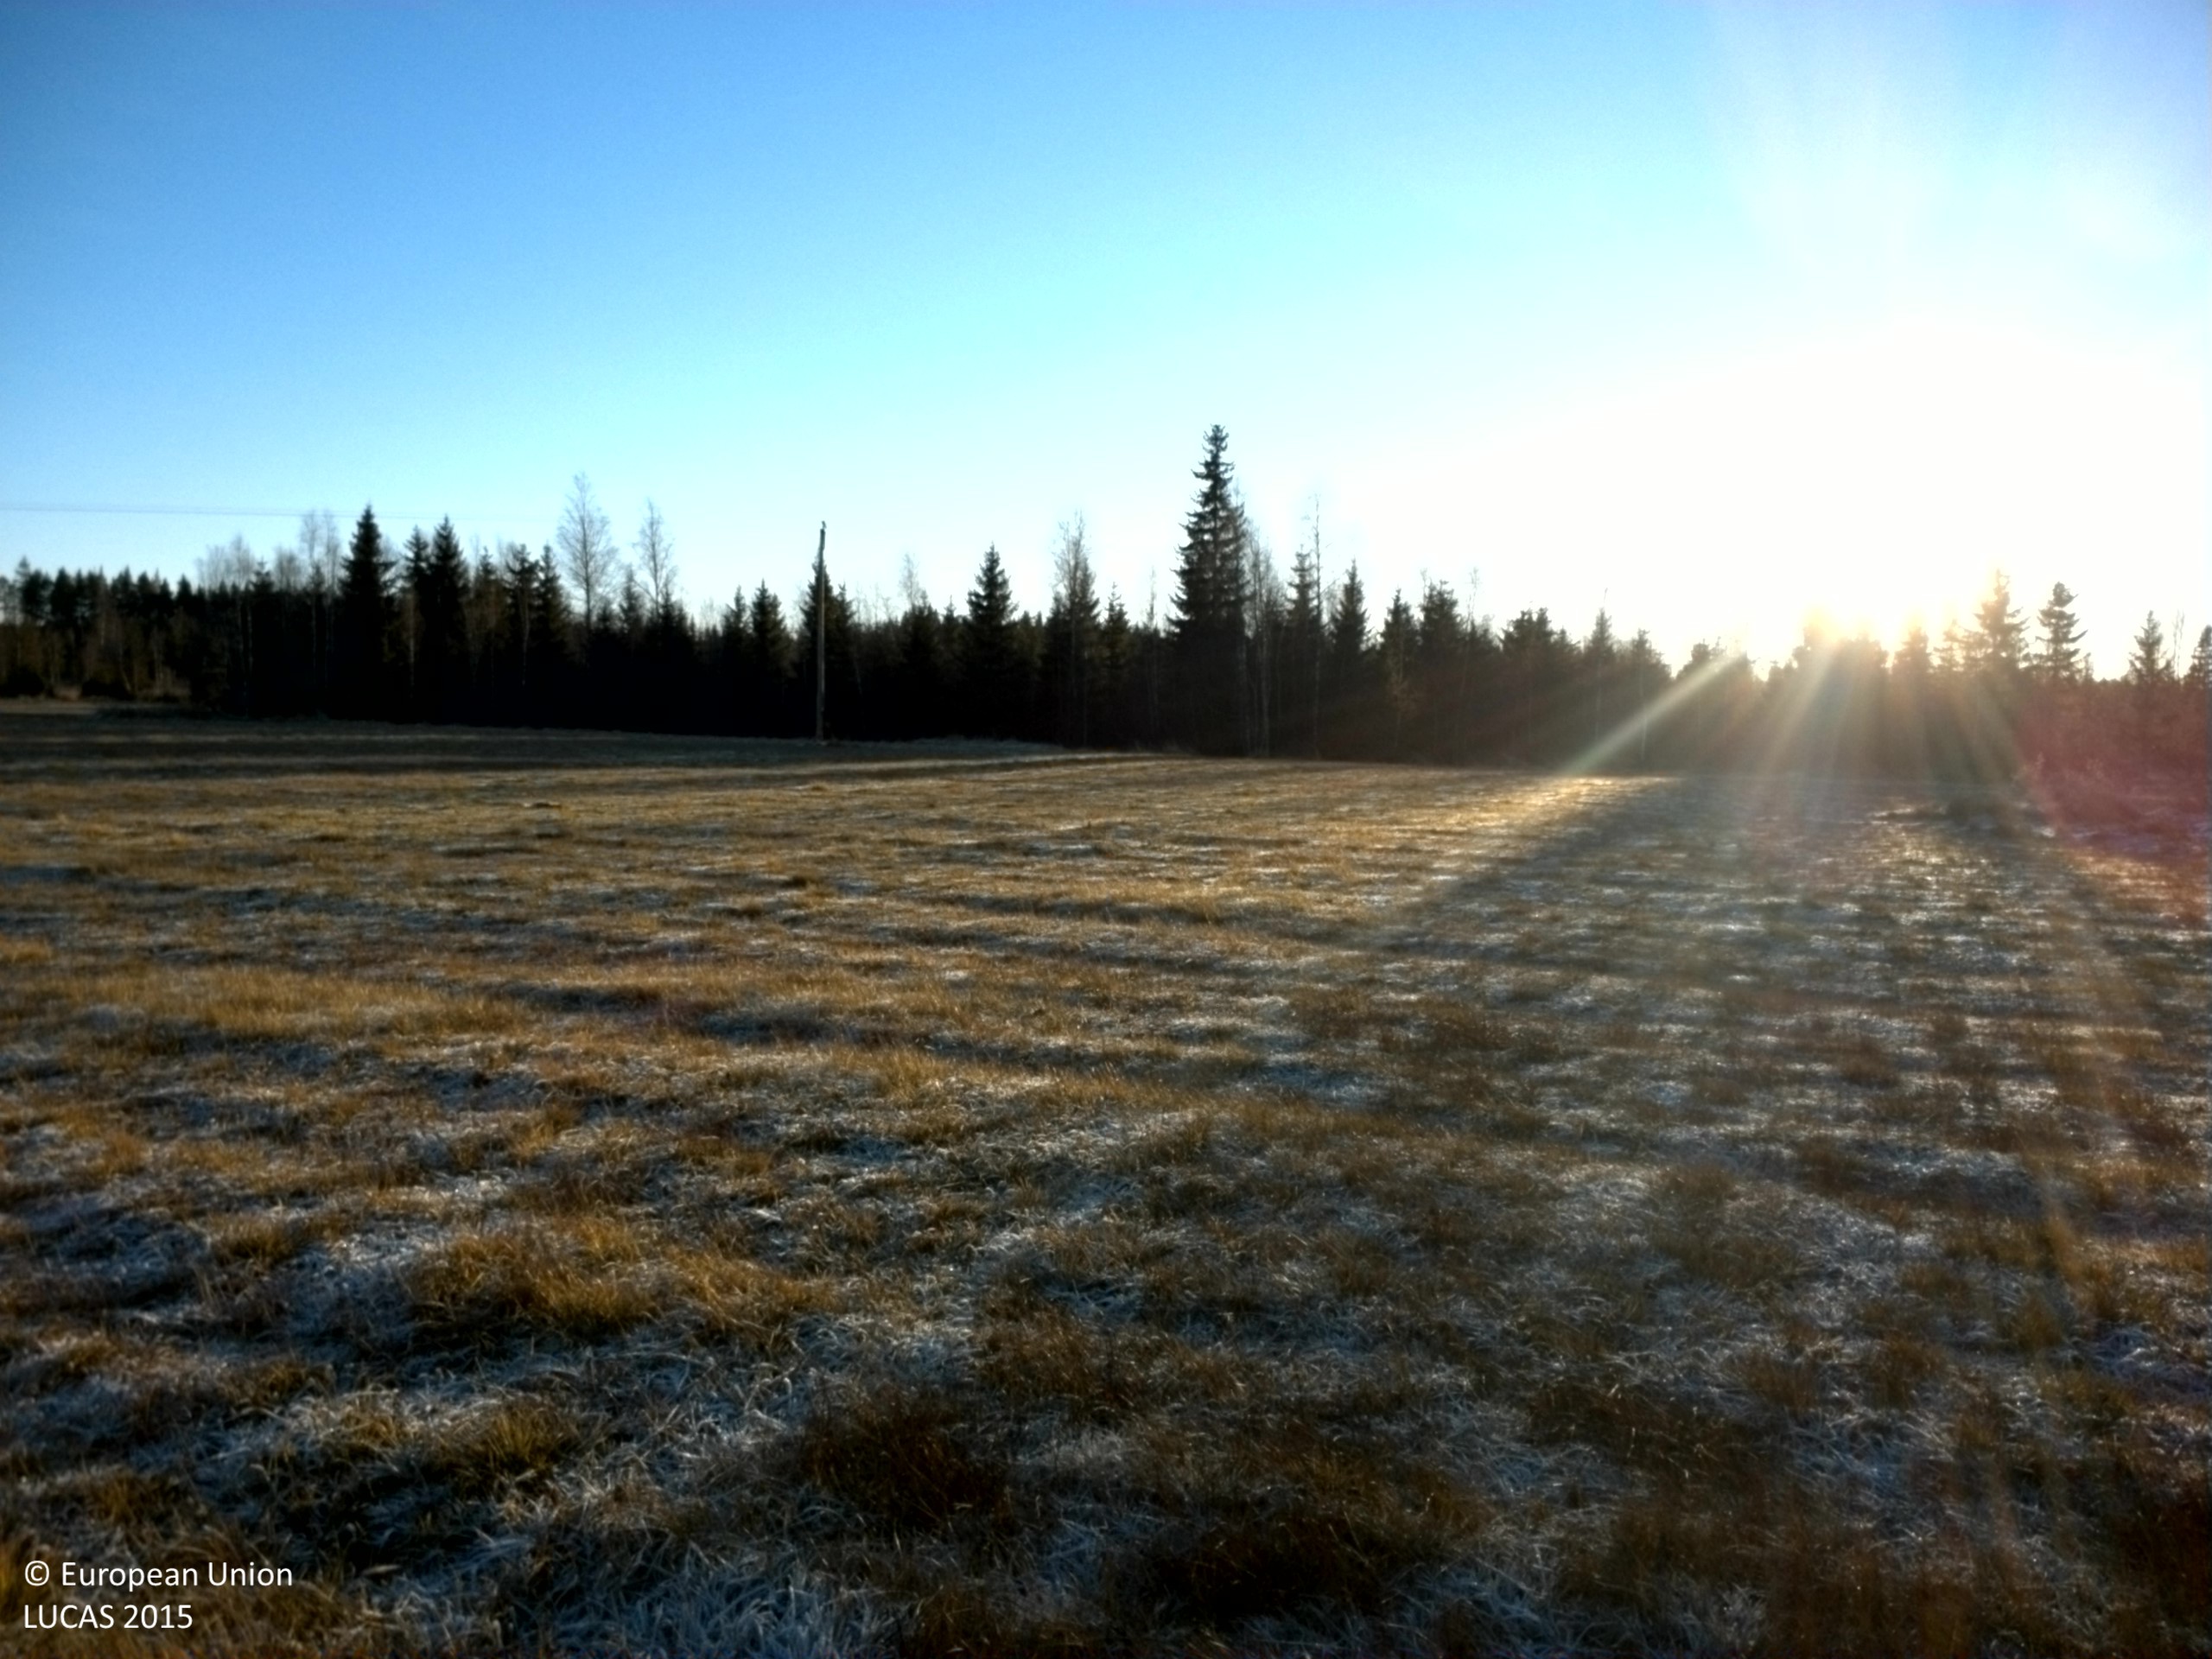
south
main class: Cropland
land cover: Mixed cereals for fodder
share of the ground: > 75 %
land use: Agriculture (excluding fallow land and kitchen gardens)
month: November
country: SE
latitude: 61.8159
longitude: 16.1887
